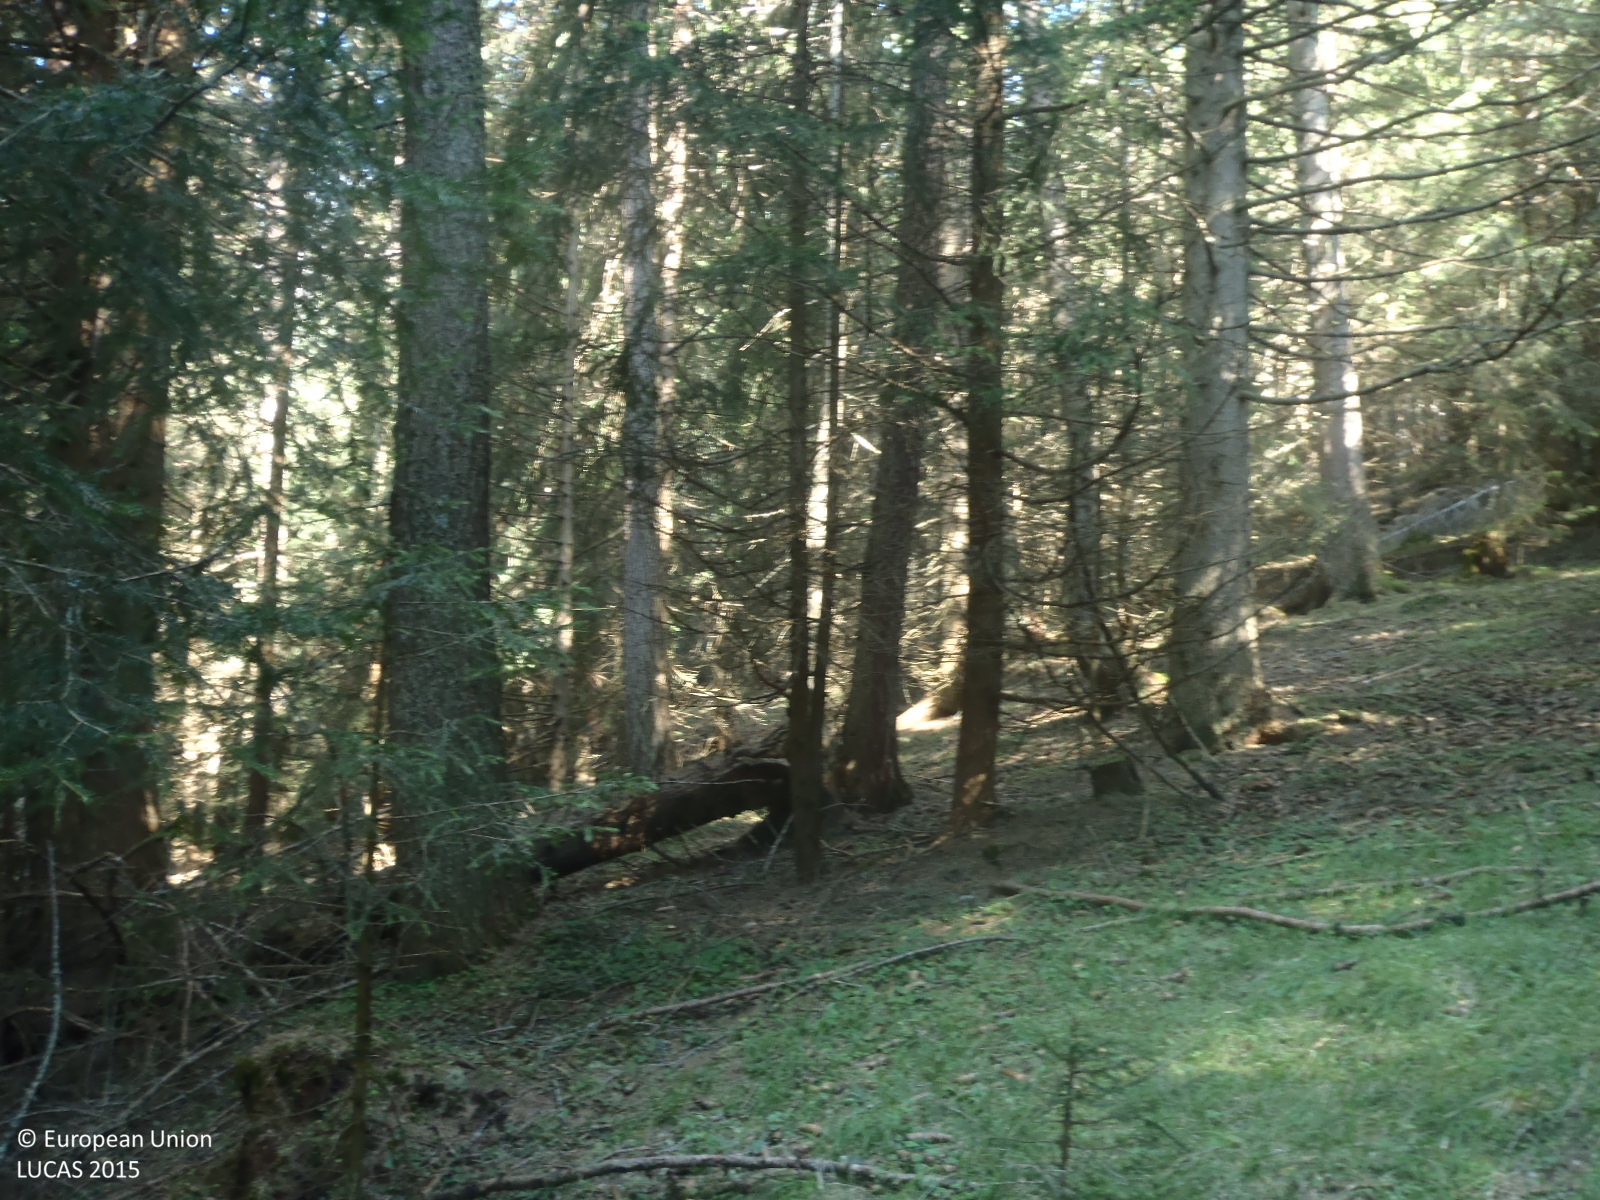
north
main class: Woodland
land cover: Spruce dominated coniferous woodland
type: alpine coniferous forest
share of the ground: > 75 %
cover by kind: coniferous forest trees 85 %, herbaceous plants 10 %, shrubs 5 %
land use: Forestry
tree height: > 5 m
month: August
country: AT
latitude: 47.0213
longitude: 12.6422
